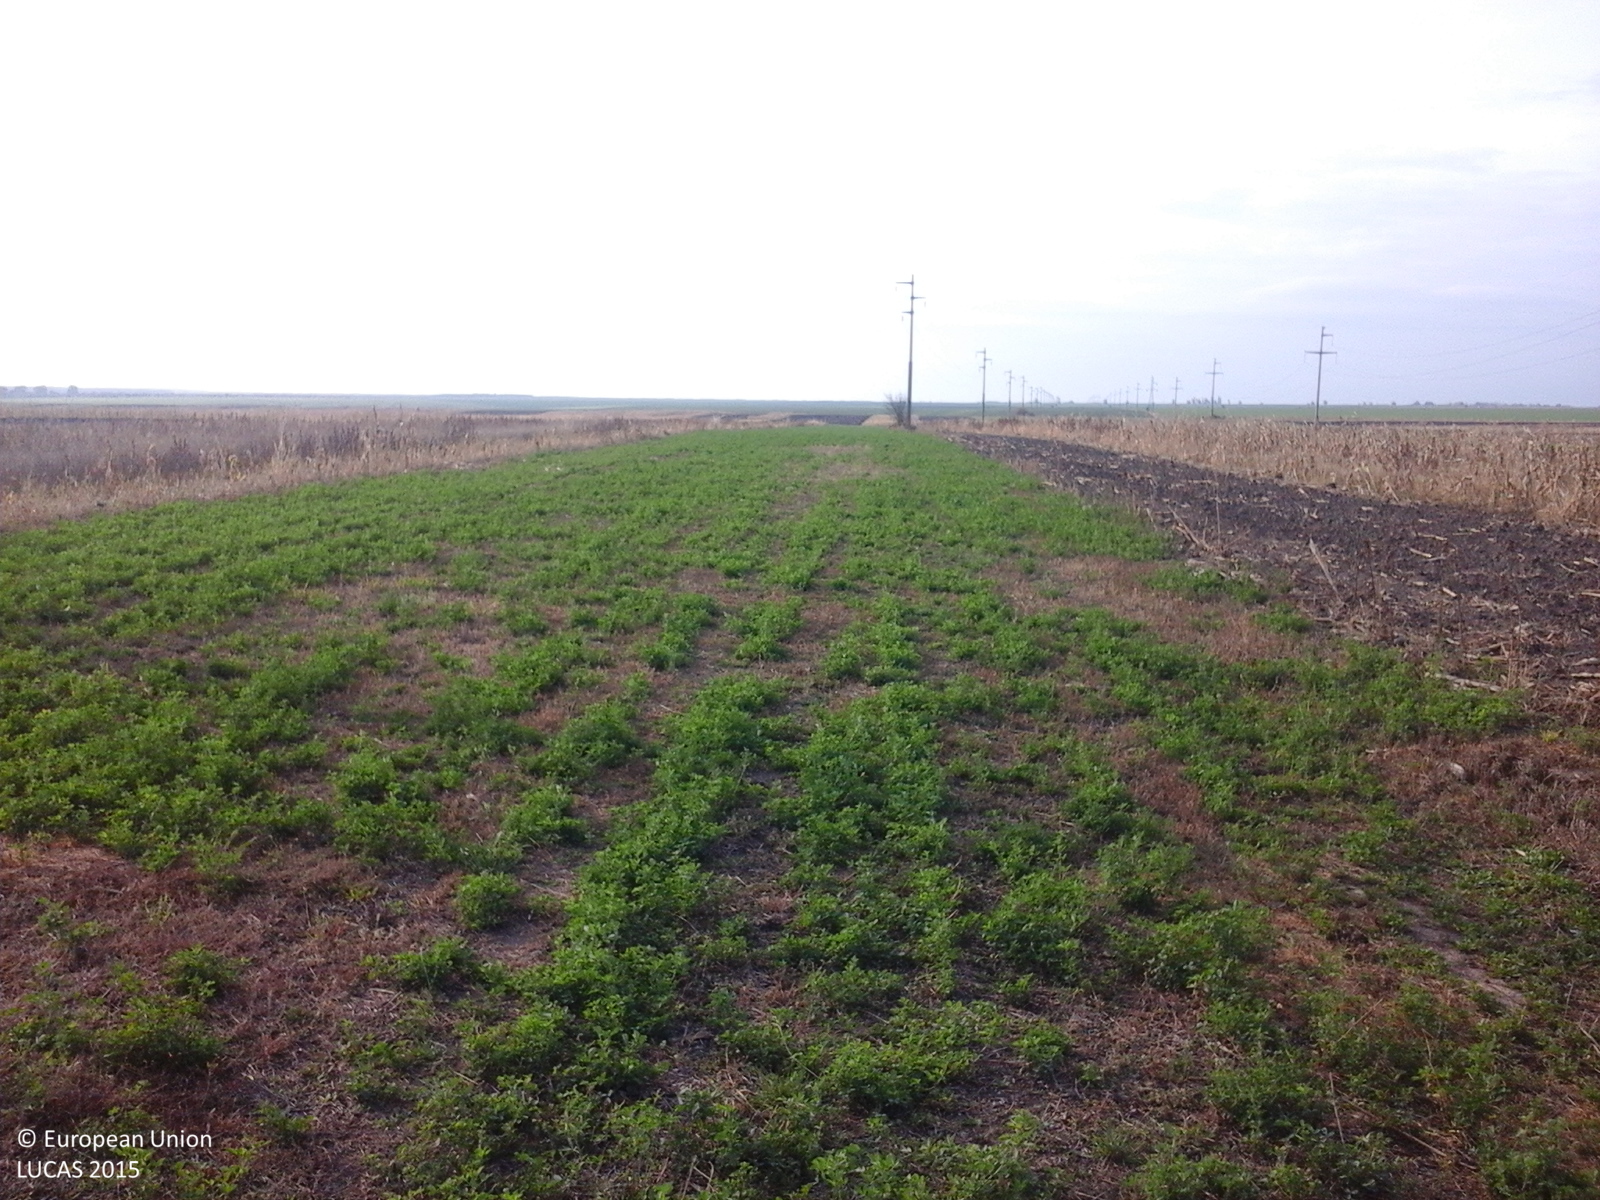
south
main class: Cropland
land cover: Lucerne
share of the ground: > 75 %
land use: Agriculture (excluding fallow land and kitchen gardens)
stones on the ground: < 10 %
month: October
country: RO
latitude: 45.4775
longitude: 27.0916
